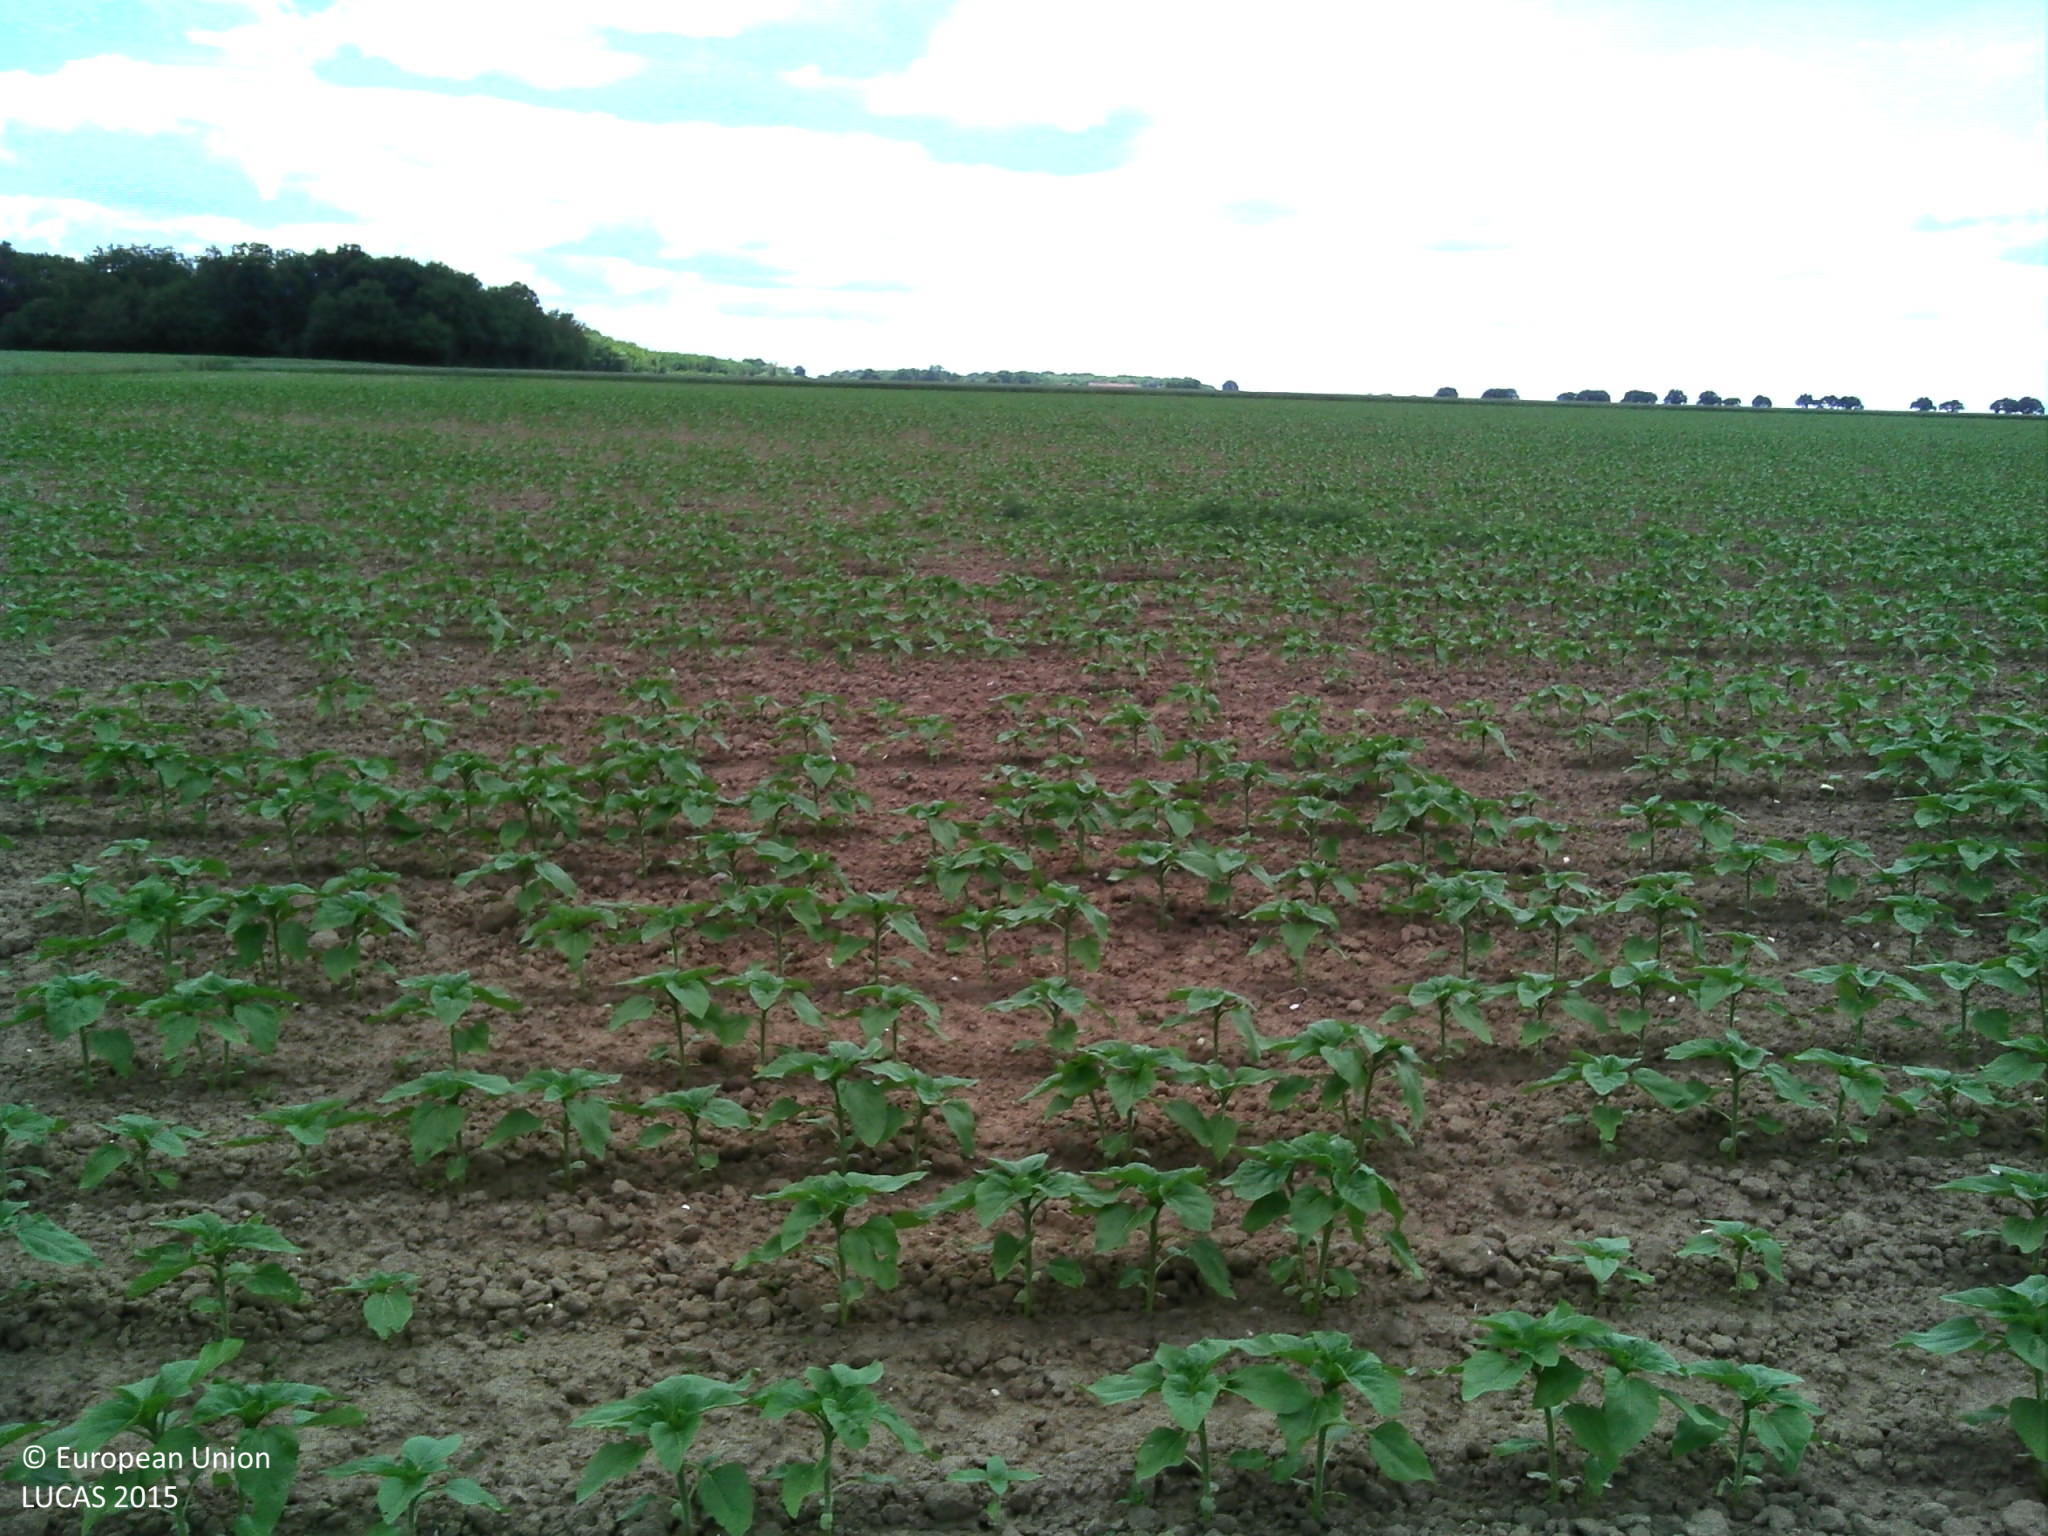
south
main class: Cropland
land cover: Sunflower
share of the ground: 25 - 50 %
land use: Agriculture (excluding fallow land and kitchen gardens)
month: May
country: FR
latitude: 47.1659
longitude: 2.9372
